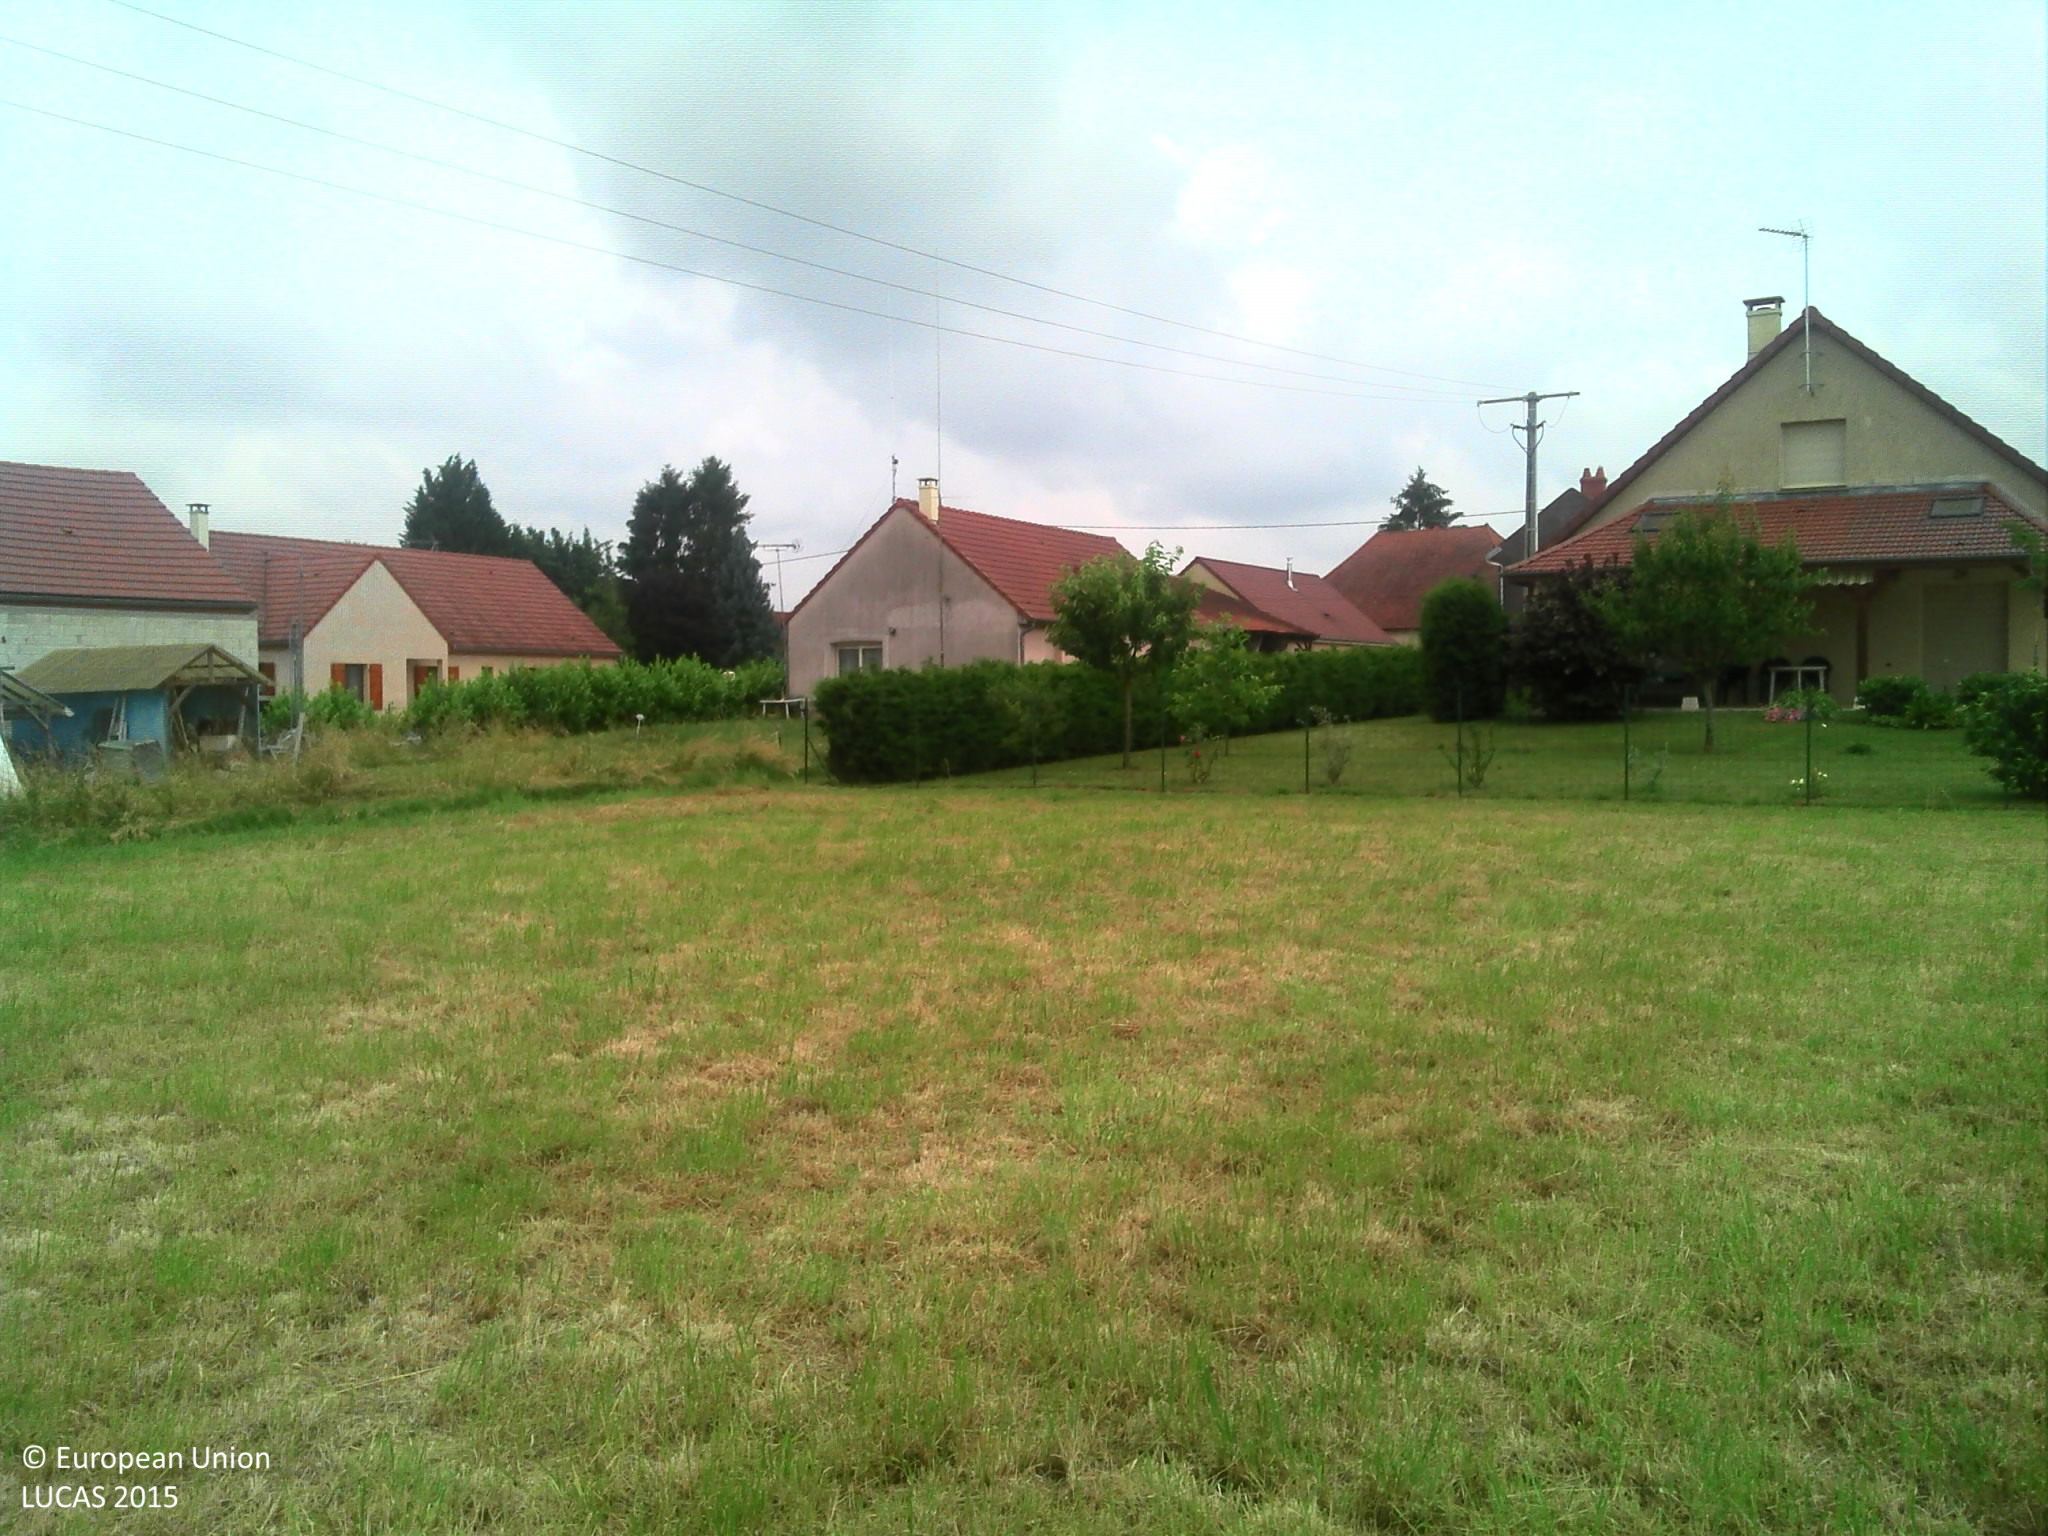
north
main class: Grassland
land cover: Grassland without tree/shrub cover
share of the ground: > 75 %
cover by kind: herbaceous plants 100 %
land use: Agriculture (excluding fallow land and kitchen gardens)
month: June
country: FR
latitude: 47.2281
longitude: 5.4447
